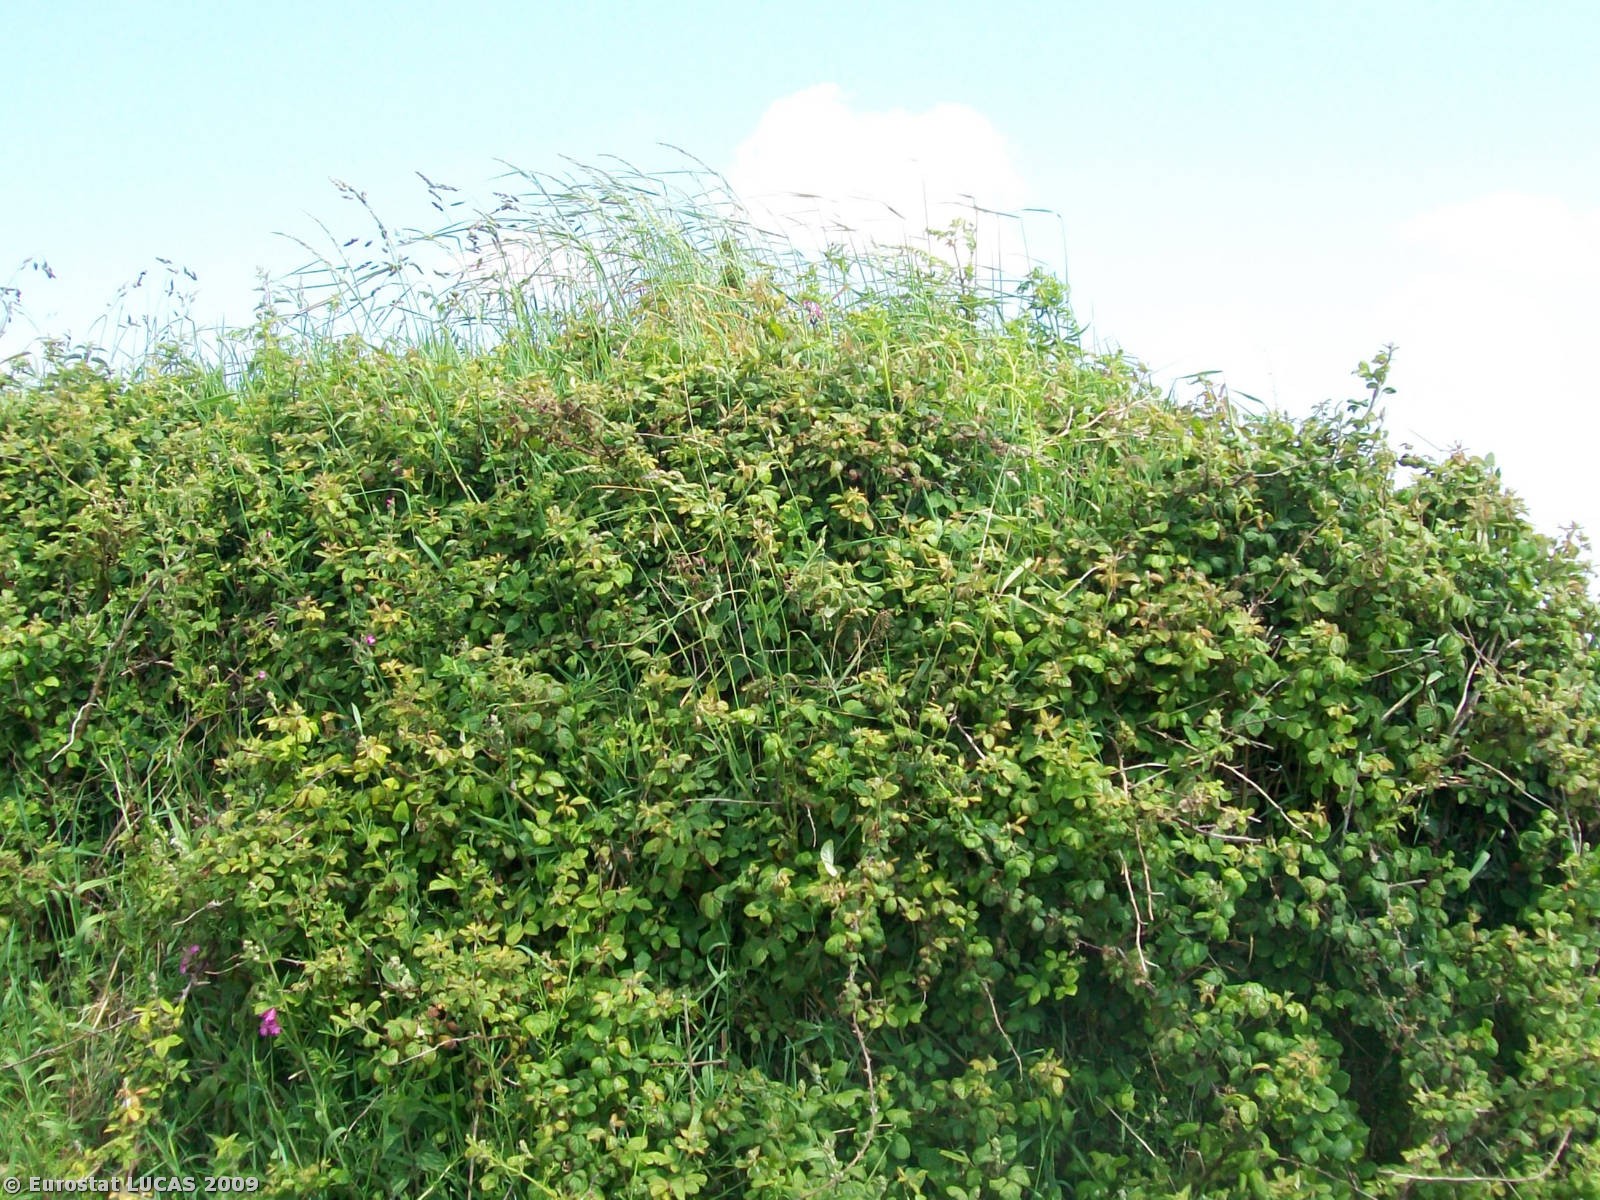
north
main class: Cropland
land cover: Temporary grasslands
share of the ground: > 75 %
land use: Agriculture (excluding fallow land and kitchen gardens)
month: June
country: GB
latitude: 50.1154
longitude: -5.1525
